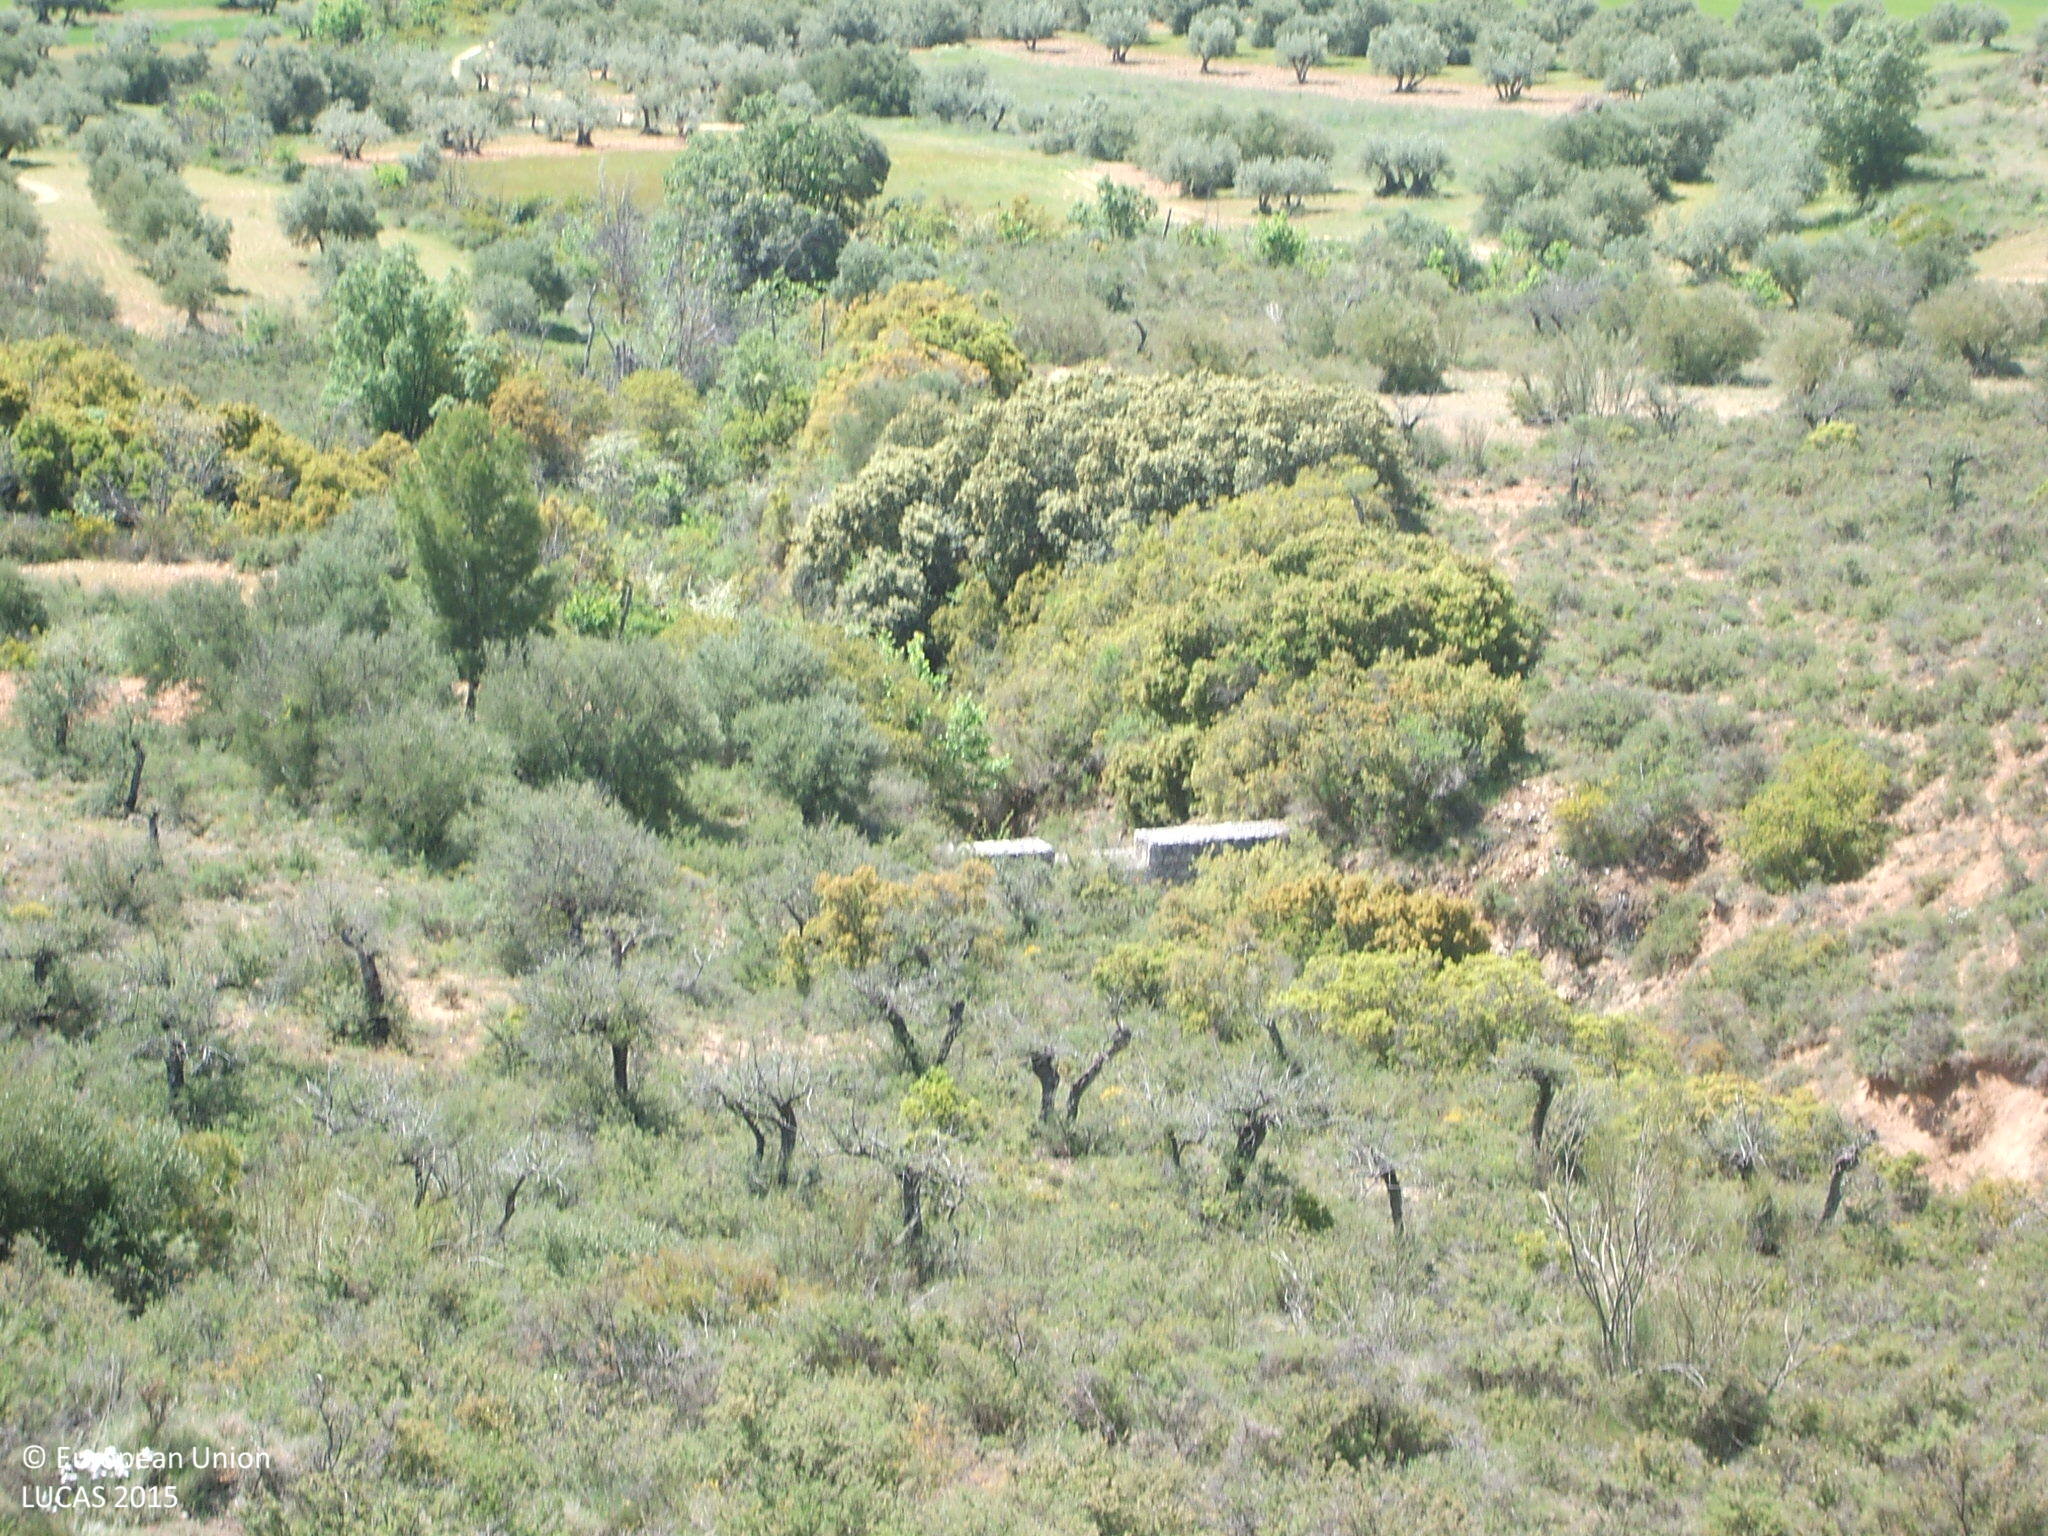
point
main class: Shrubland
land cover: Shrubland without tree cover
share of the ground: 25 - 50 %
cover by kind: herbaceous plants 55 %, shrubs 45 %
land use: Semi-natural and natural areas not in use
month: May
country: ES
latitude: 40.8292
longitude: -2.9704
